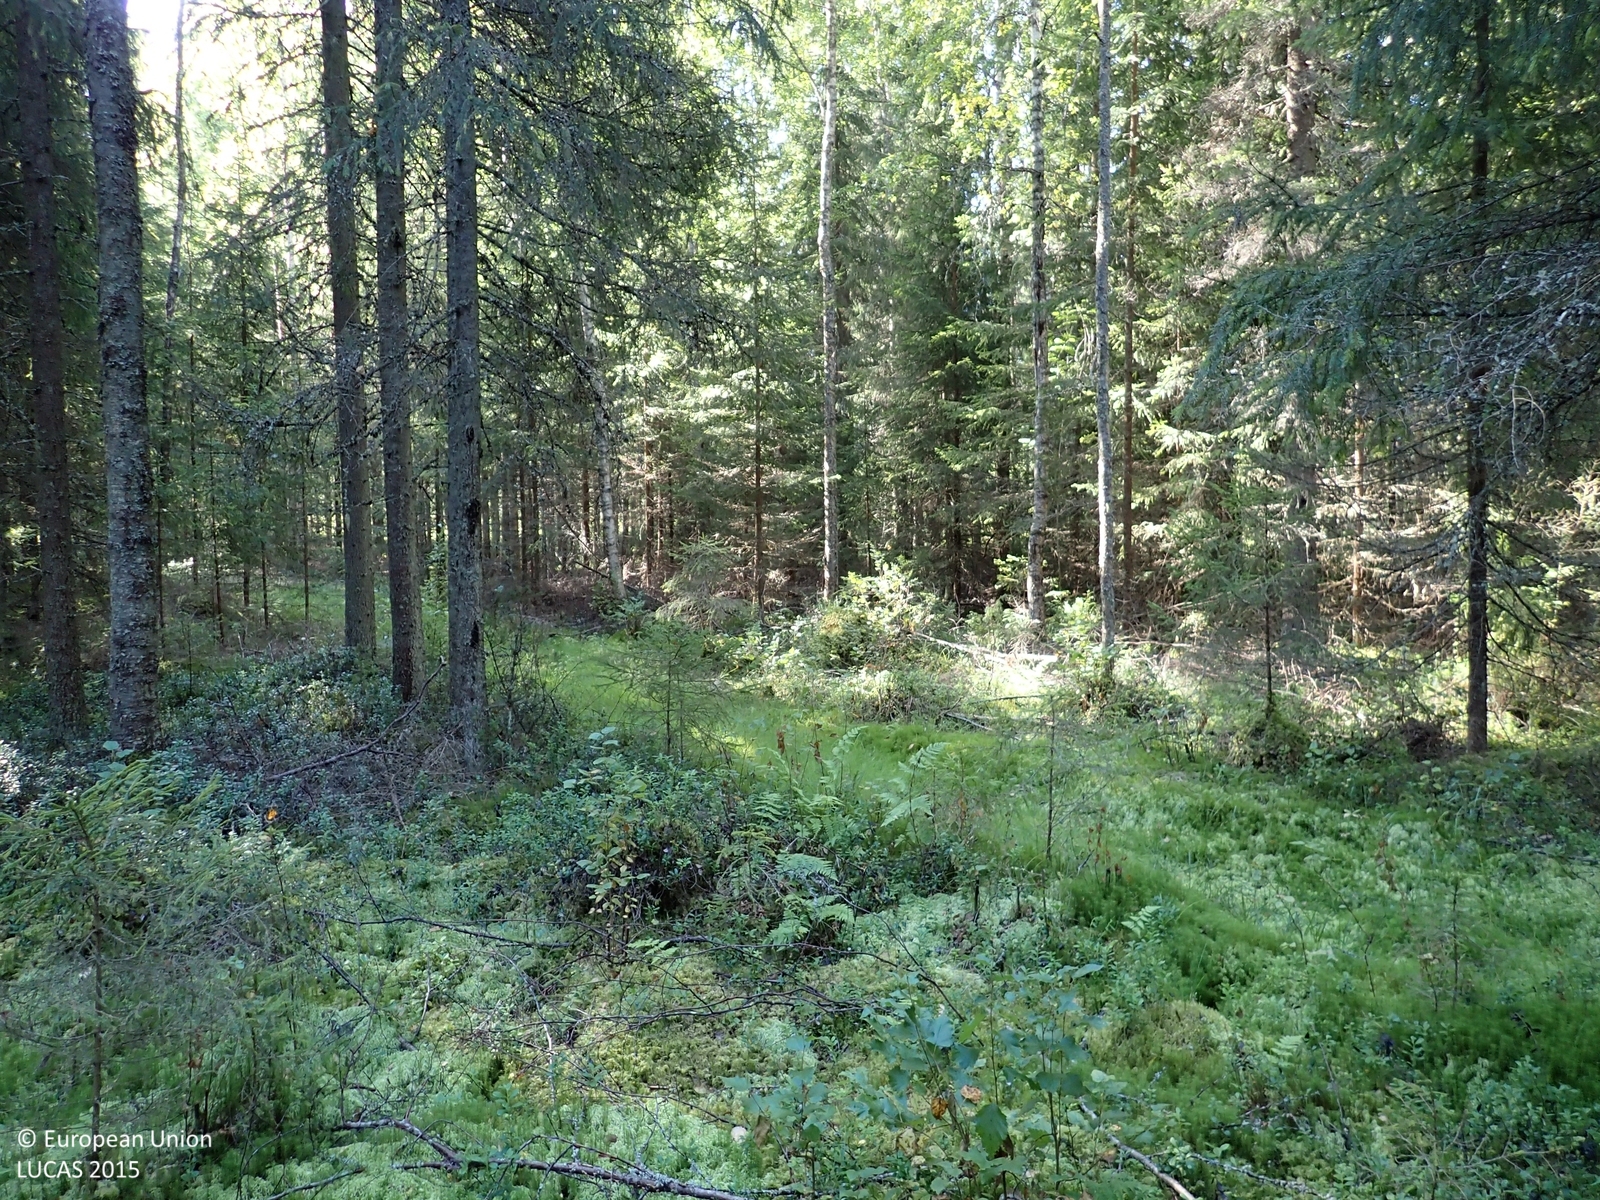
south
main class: Woodland
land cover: Spruce dominated mixed woodland
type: boreal forest
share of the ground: > 75 %
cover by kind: coniferous forest trees 55 %, broadleaved forest trees 20 %, shrubs 10 %, lichens and mosses 10 %, herbaceous plants 5 %
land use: Forestry
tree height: > 5 m
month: August
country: FI
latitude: 62.4769
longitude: 21.7823
